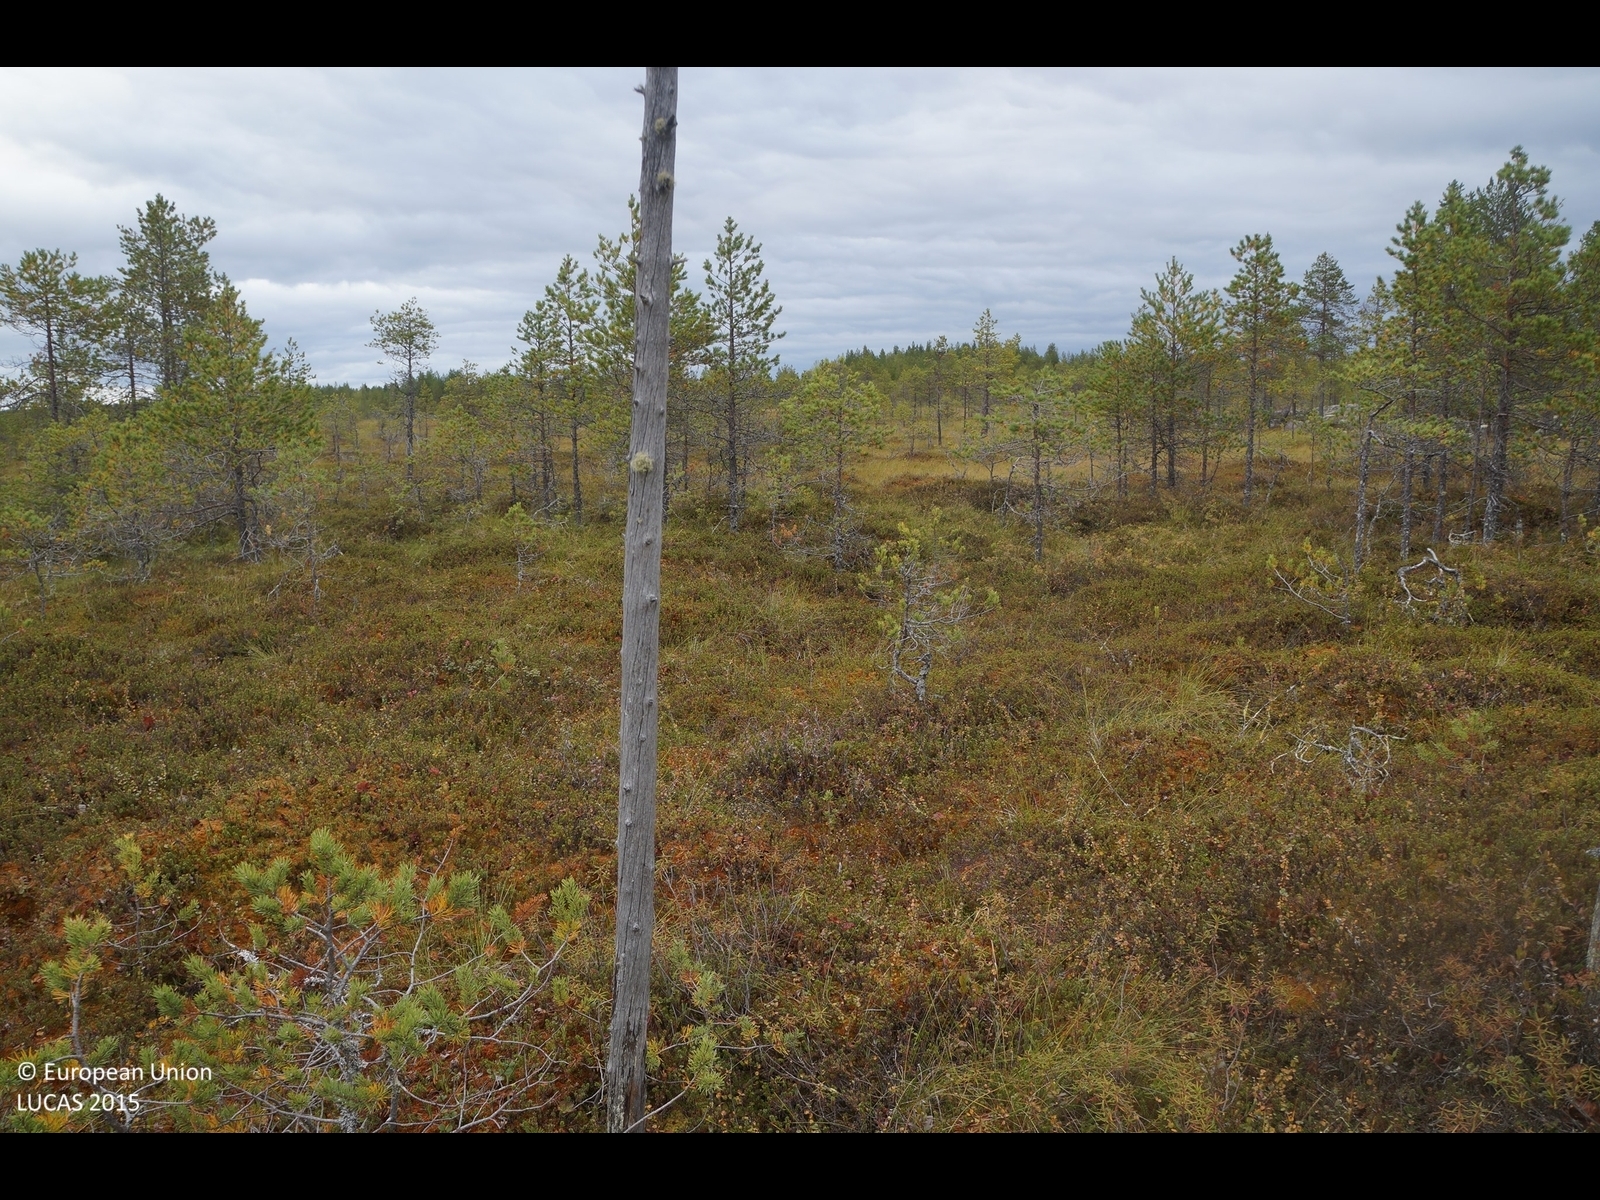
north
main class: Woodland
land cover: Pine dominated coniferous woodland
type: boreal forest
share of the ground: 25 - 50 %
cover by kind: shrubs 30 %, lichens and mosses 30 %, coniferous forest trees 25 %, herbaceous plants 15 %
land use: Semi-natural and natural areas not in use
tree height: < 5 m
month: September
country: FI
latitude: 64.0200
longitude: 24.1237
